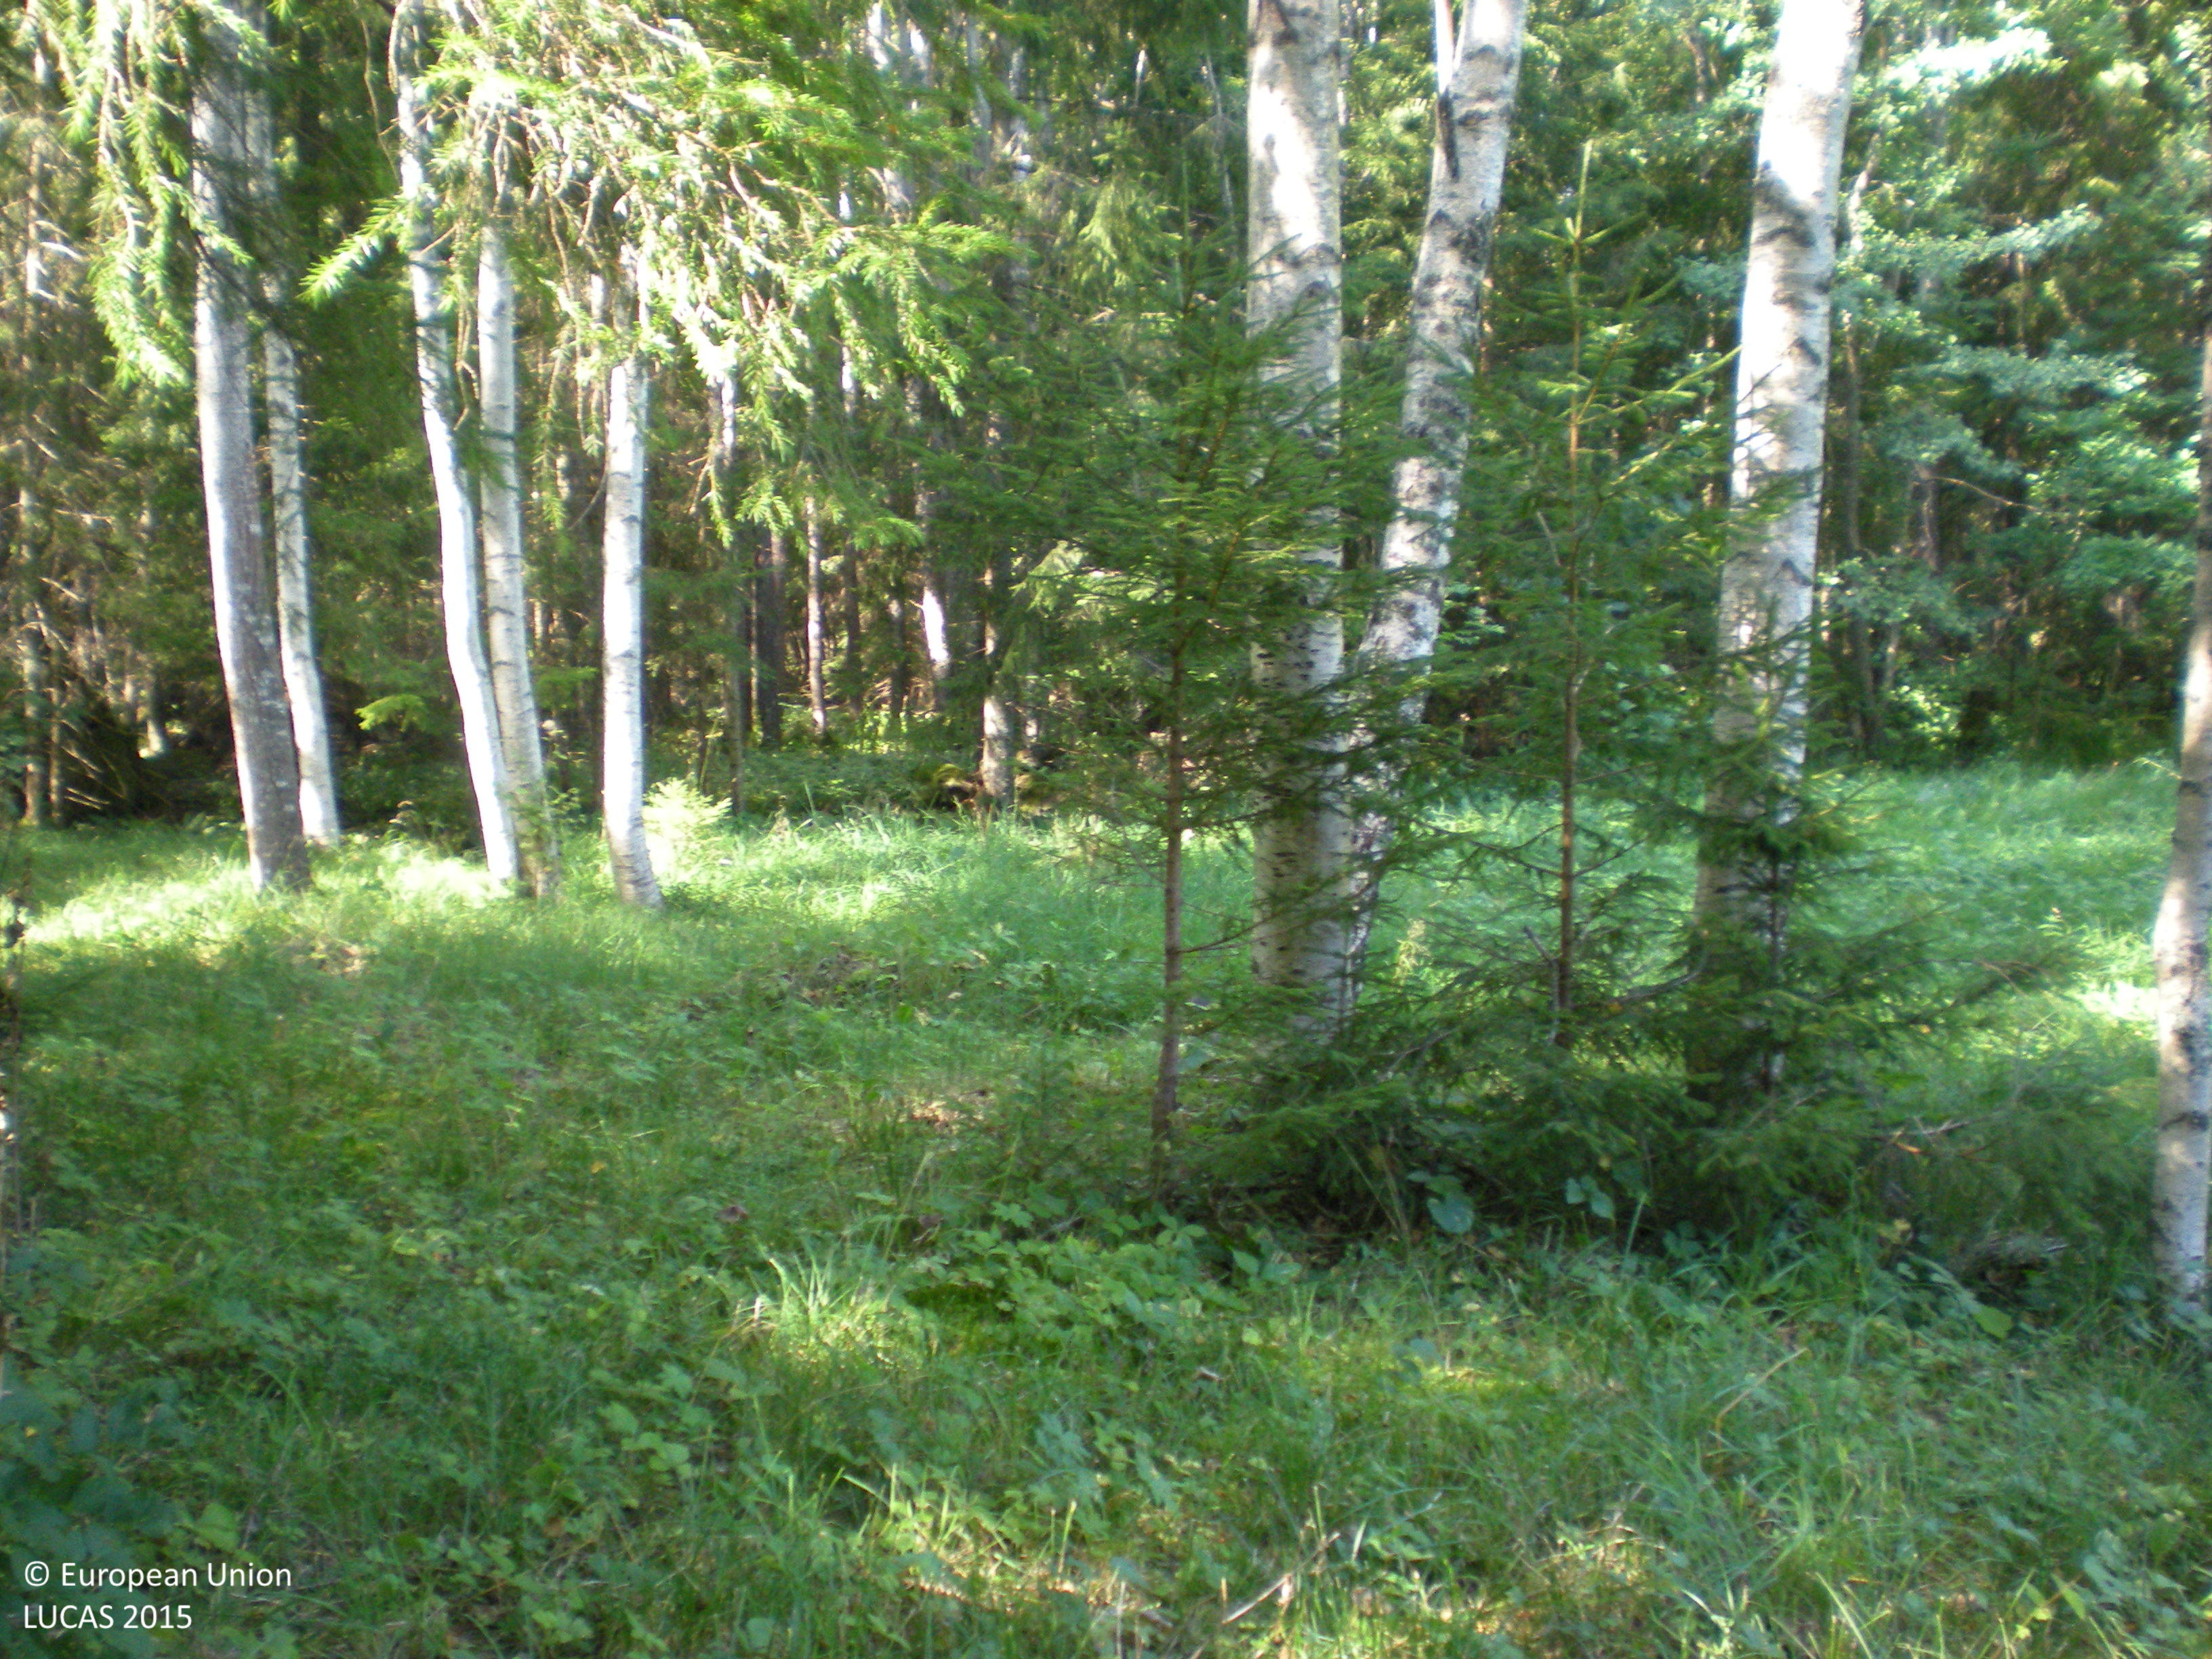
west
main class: Woodland
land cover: Broadleaved woodland
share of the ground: 25 - 50 %
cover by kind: broadleaved forest trees 40 %, herbaceous plants 40 %, coniferous forest trees 10 %, shrubs 5 %, lichens and mosses 5 %
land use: Forestry
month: August
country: SE
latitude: 60.6201
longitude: 17.3906
